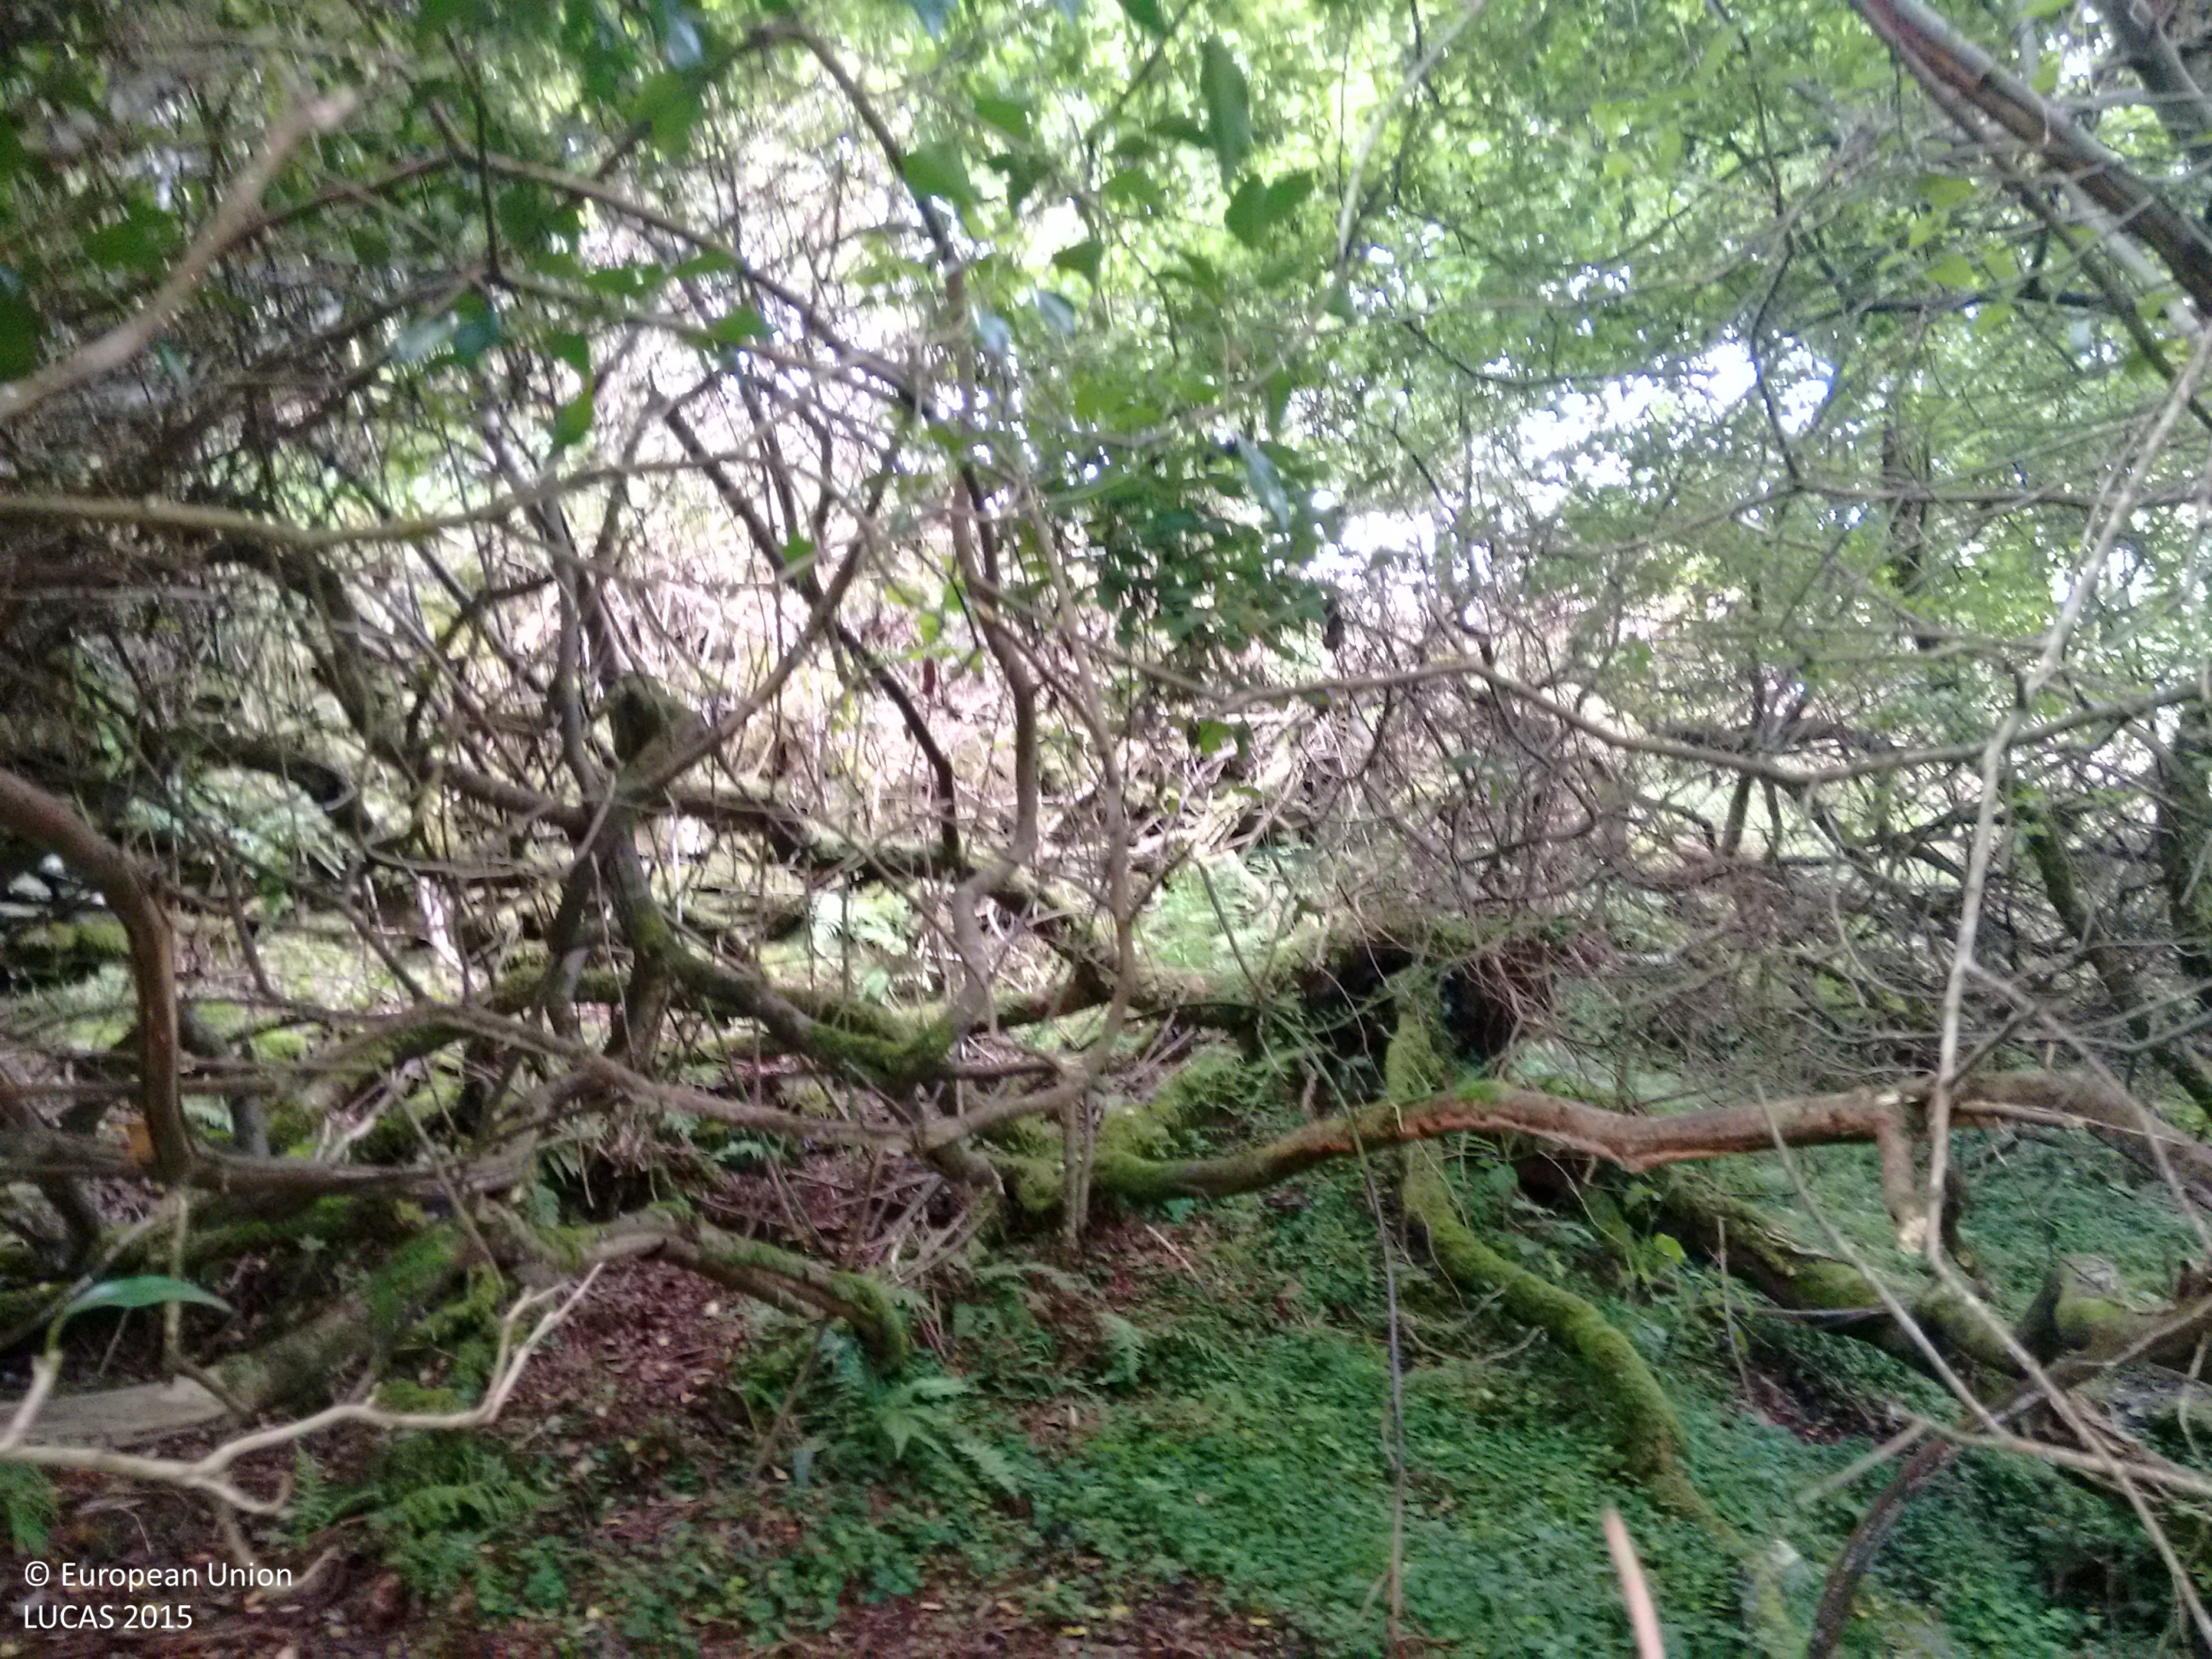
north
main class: Woodland
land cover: Broadleaved woodland
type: mesophytic deciduous forest
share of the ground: > 75 %
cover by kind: broadleaved forest trees 100 %
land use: Semi-natural and natural areas not in use
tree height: < 5 m
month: August
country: IE
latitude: 51.9729
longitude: -9.3095
